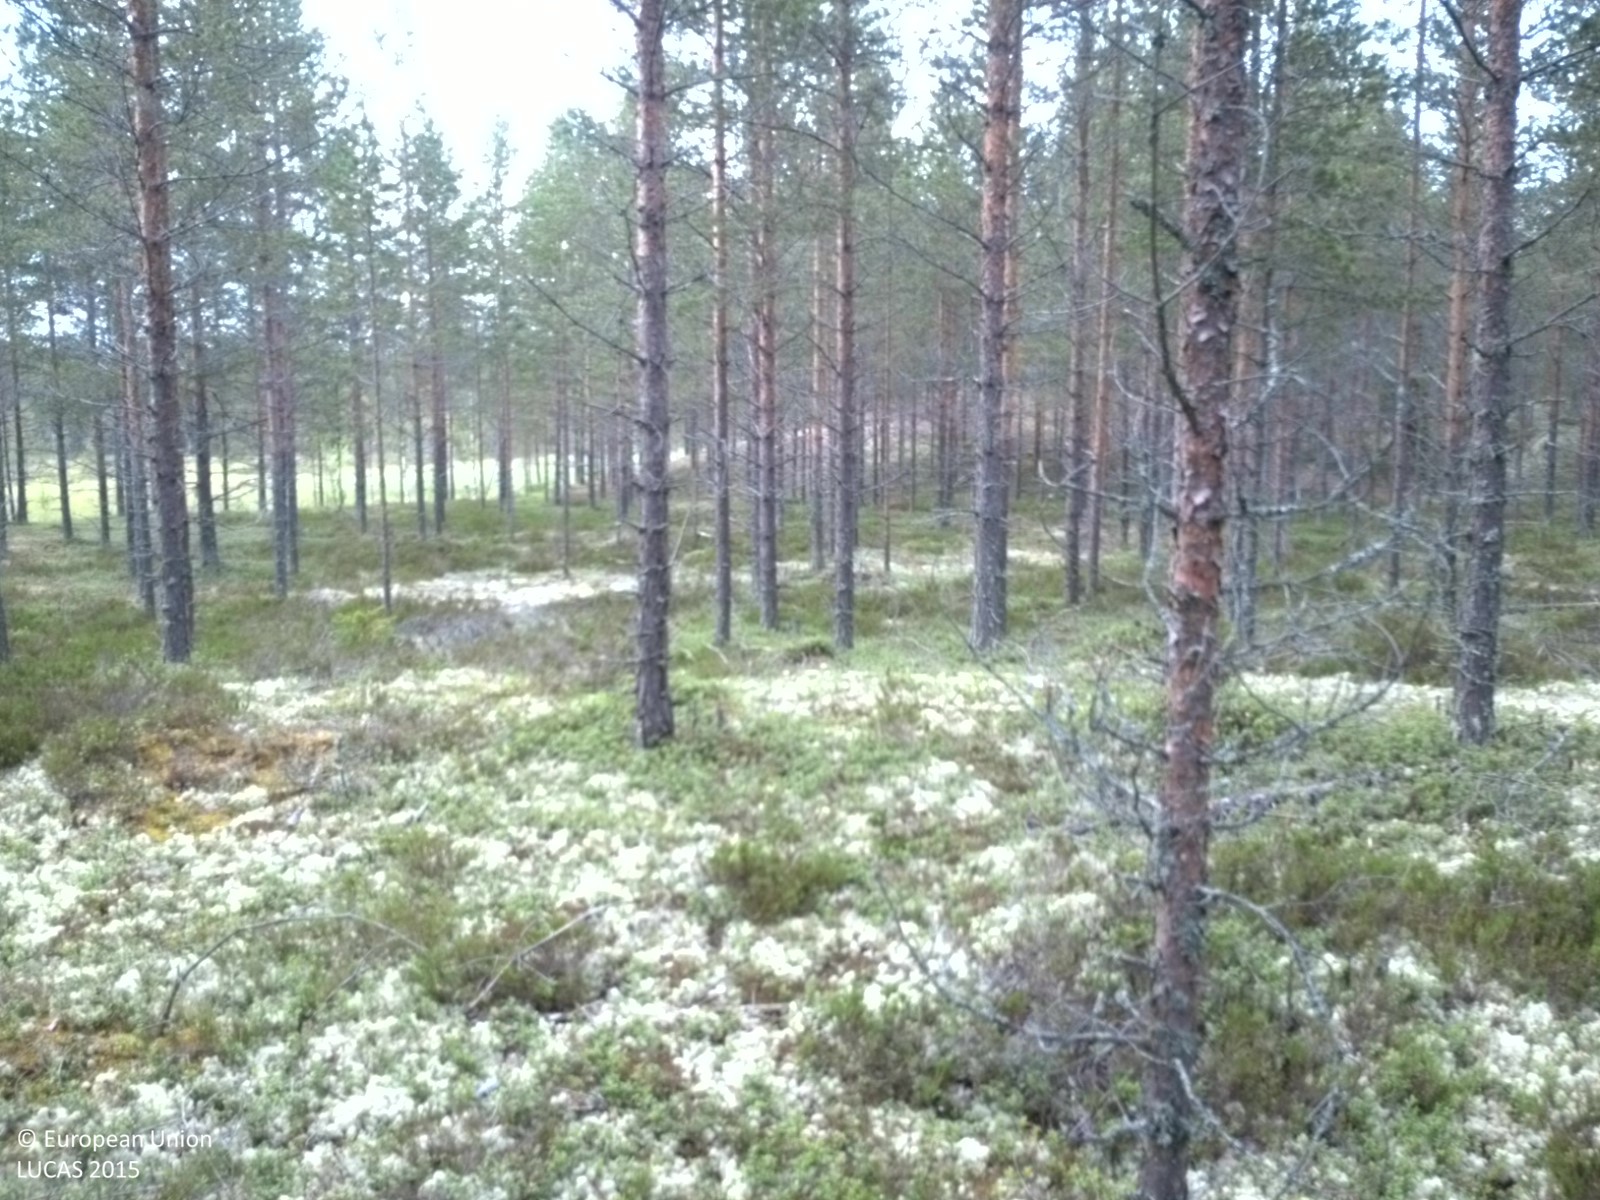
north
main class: Woodland
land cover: Pine dominated coniferous woodland
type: boreal forest
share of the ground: 25 - 50 %
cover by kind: lichens and mosses 75 %, coniferous forest trees 25 %
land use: Forestry
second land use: Amenities, museums, leisure
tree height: > 5 m
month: July
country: SE
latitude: 63.5893
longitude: 19.4297
